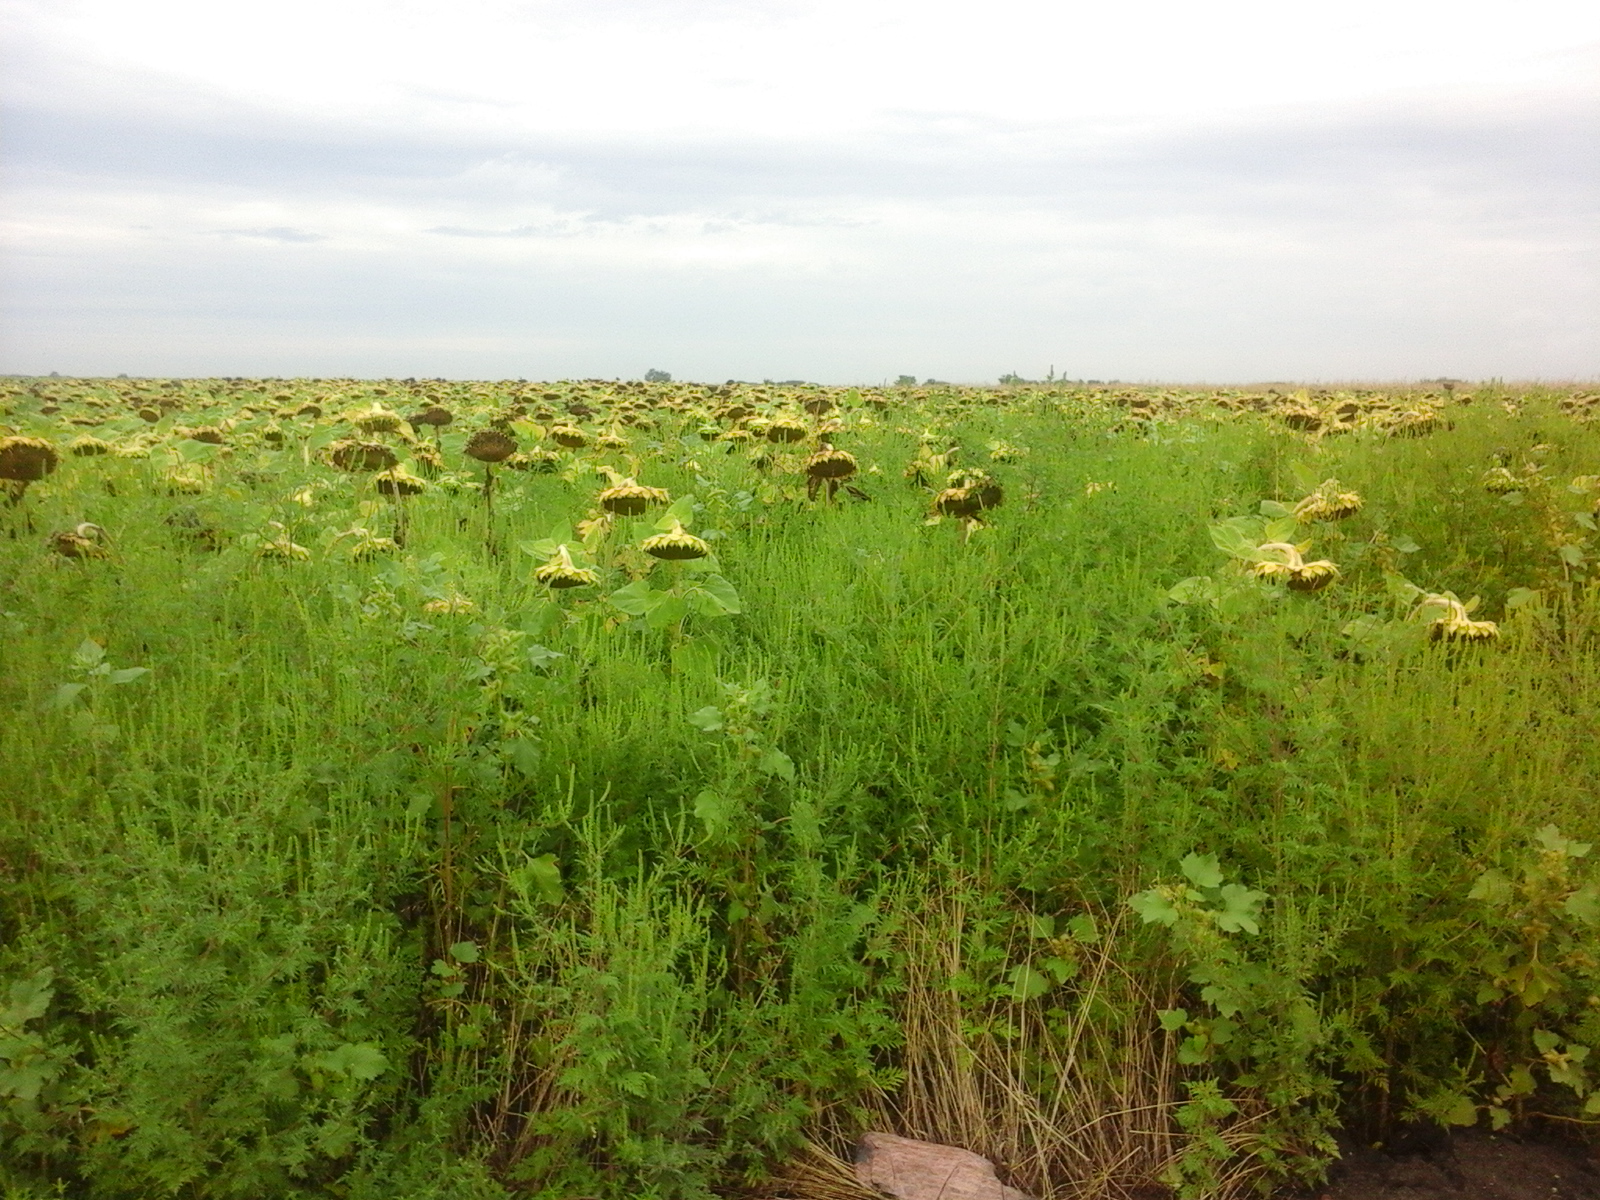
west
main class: Cropland
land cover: Sunflower
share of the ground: > 75 %
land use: Agriculture (excluding fallow land and kitchen gardens)
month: August
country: RO
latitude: 45.6021
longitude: 21.3260
